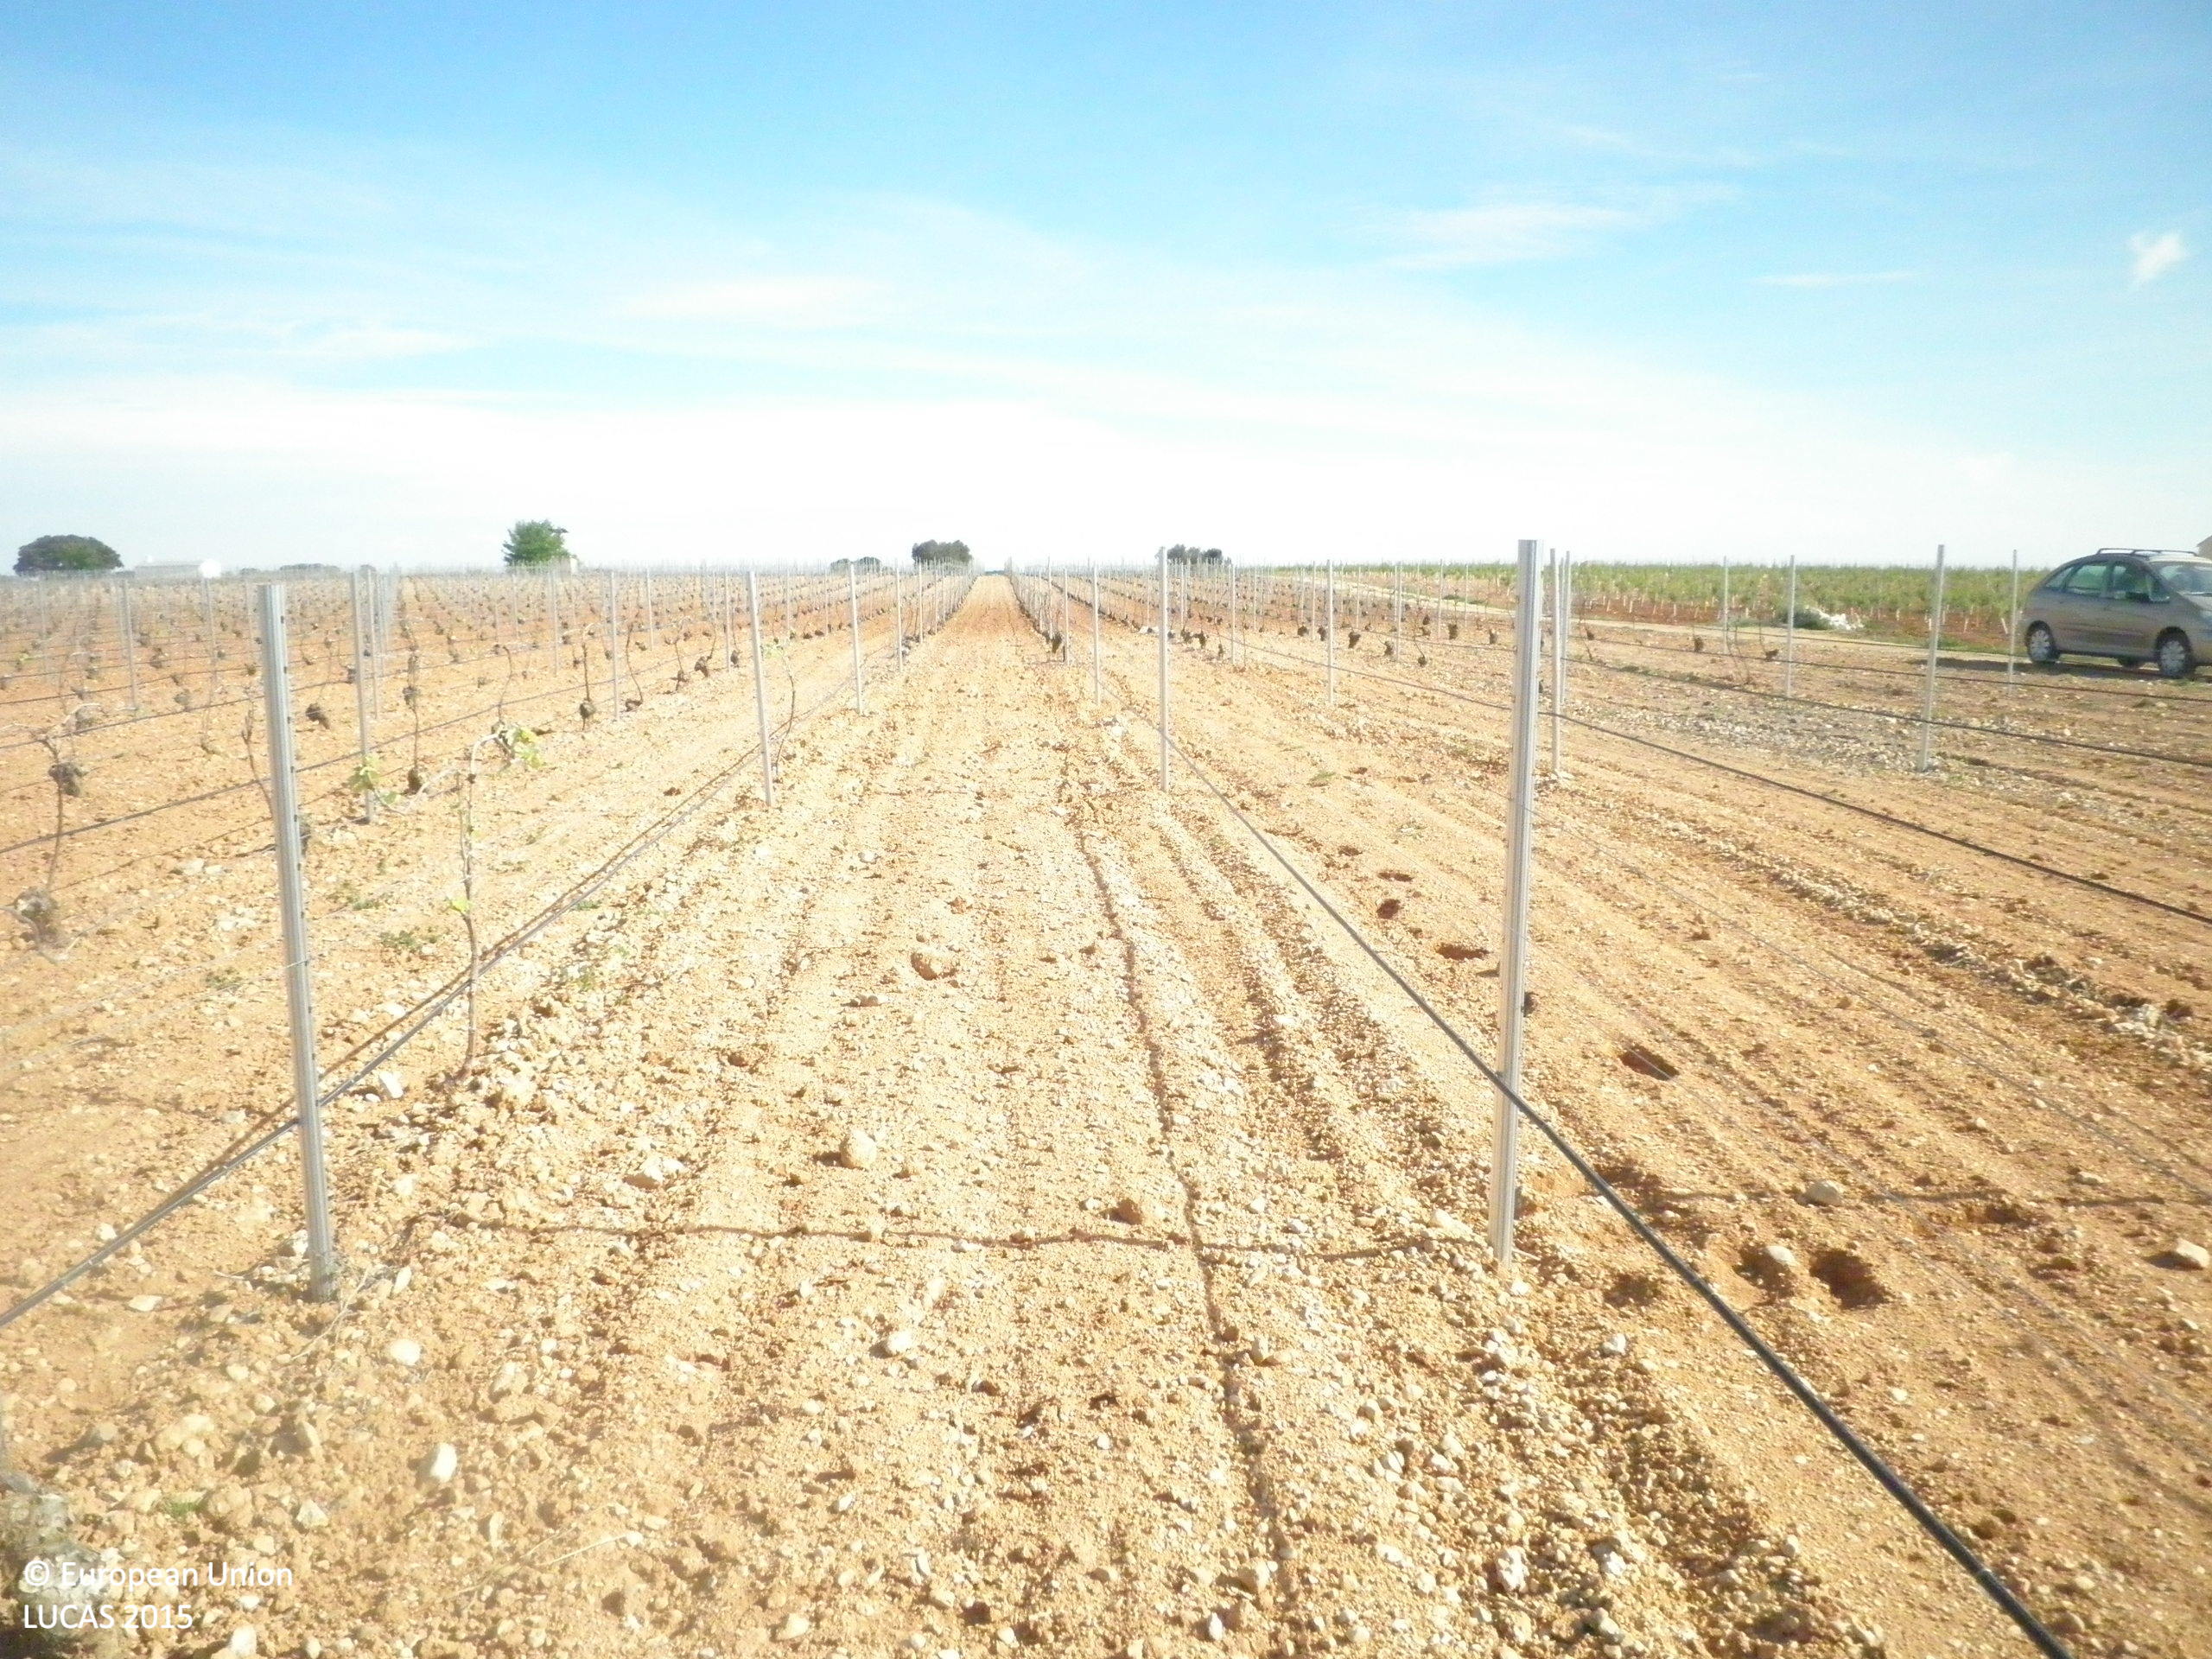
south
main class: Cropland
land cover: Vineyards
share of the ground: < 10 %
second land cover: Other bare soil
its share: > 75 %
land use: Agriculture (excluding fallow land and kitchen gardens)
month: April
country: ES
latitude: 39.3654
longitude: -2.6983
